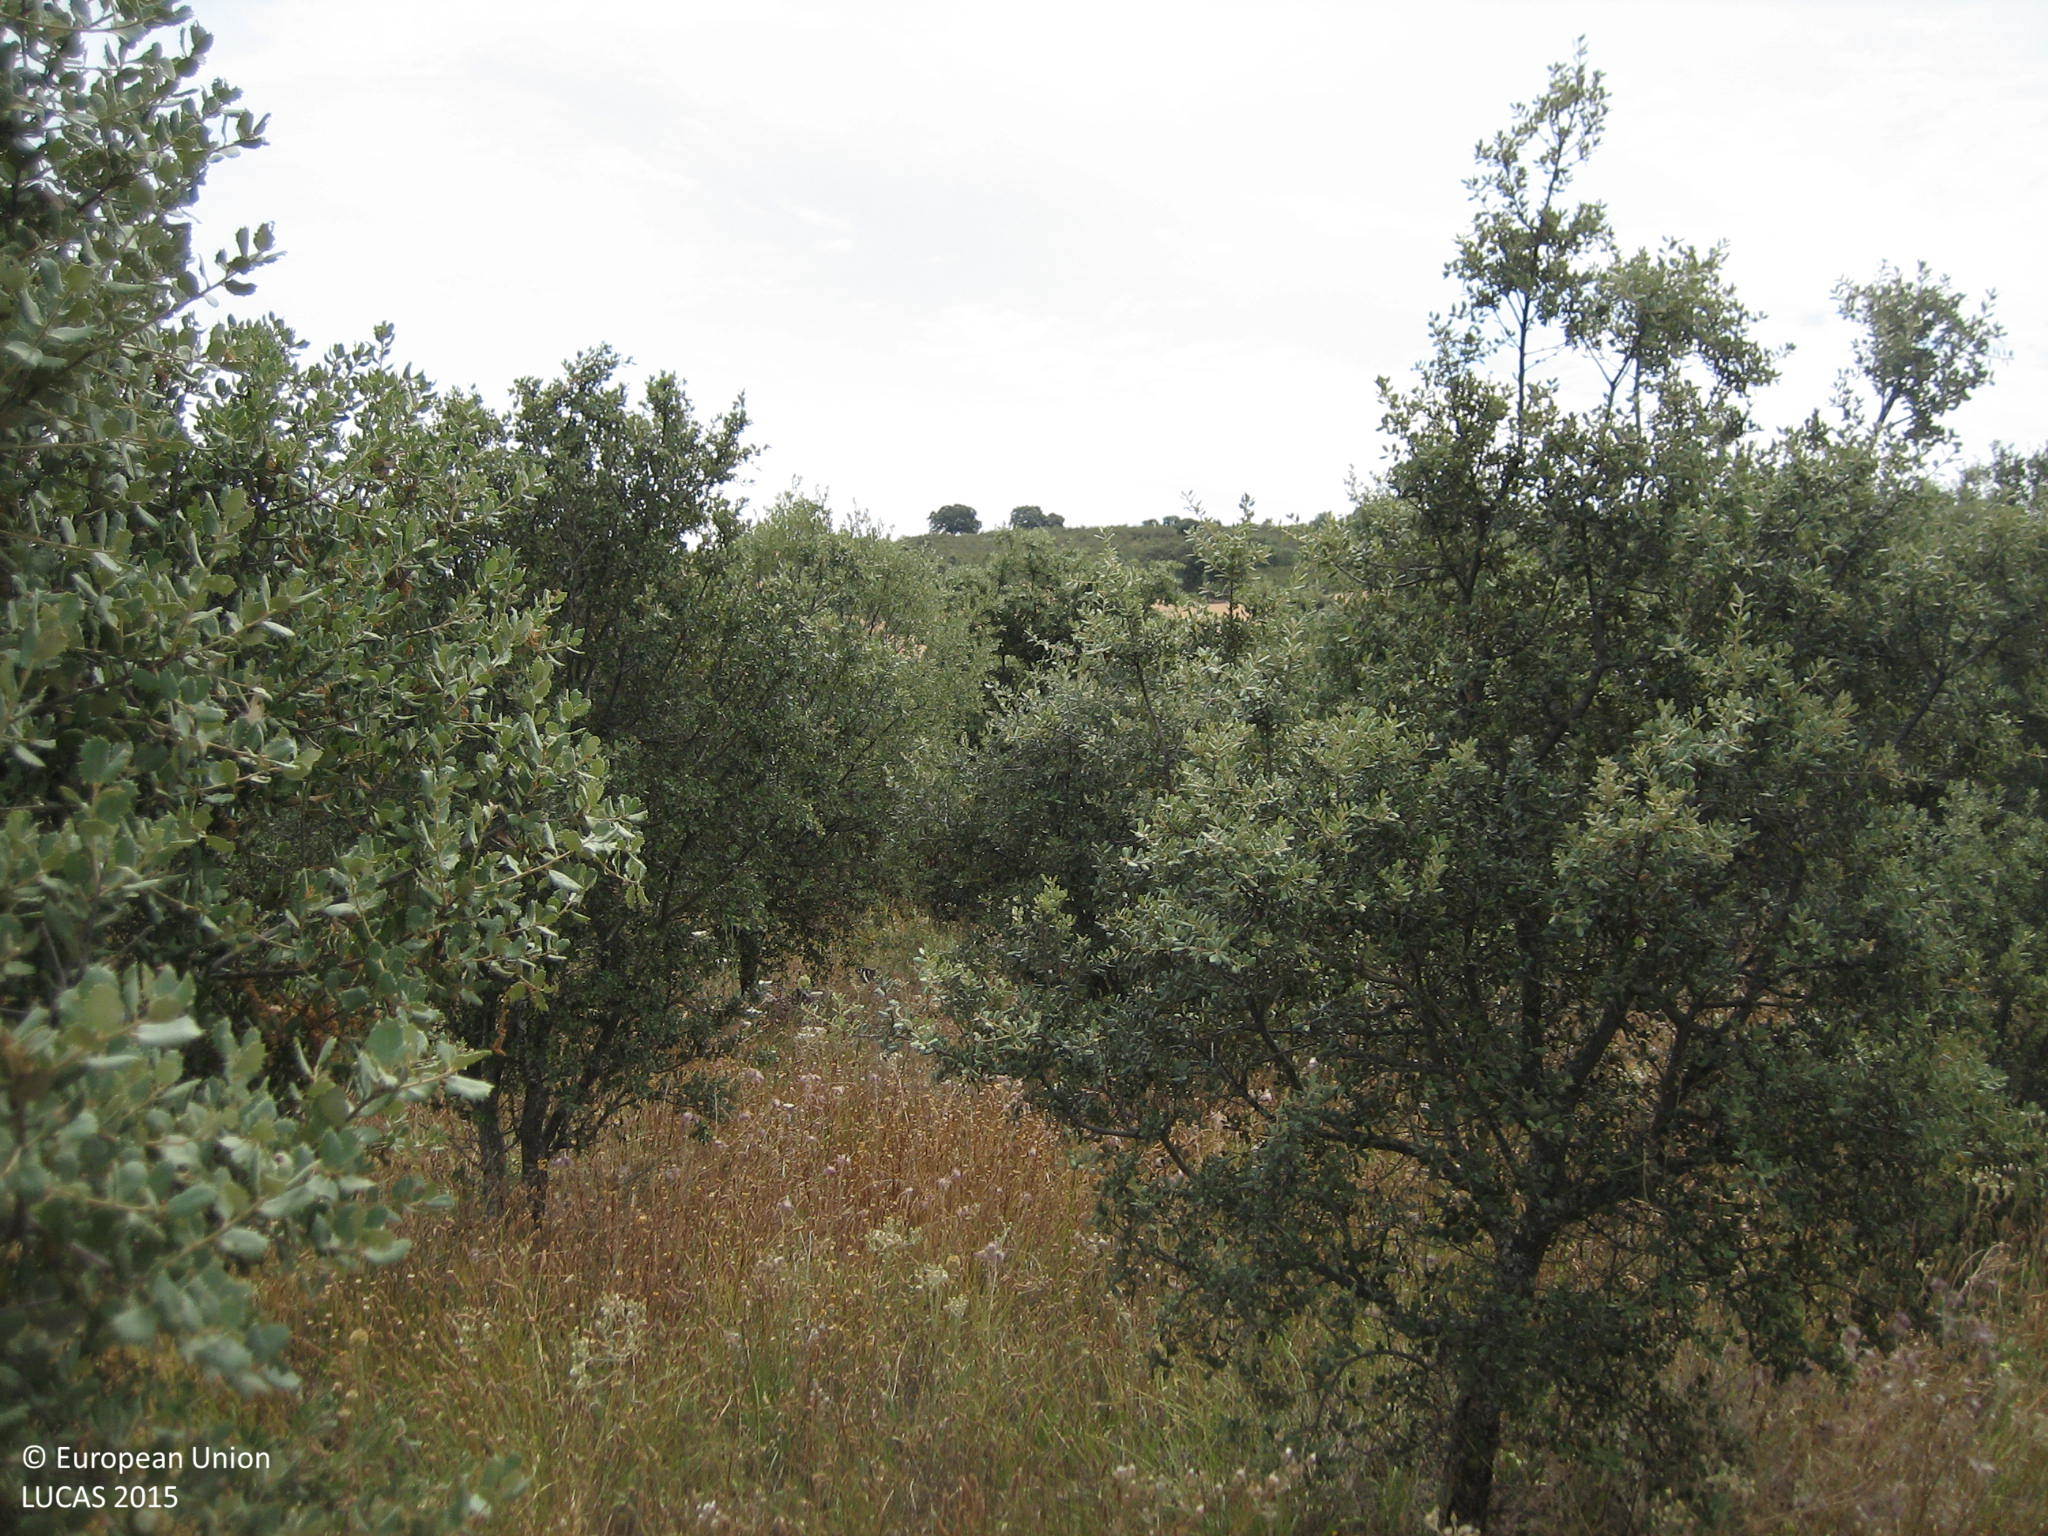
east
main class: Woodland
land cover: Broadleaved woodland
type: broadleaved evergreen forest
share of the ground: 25 - 50 %
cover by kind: herbaceous plants 60 %, broadleaved forest trees 40 %
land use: Forestry
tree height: < 5 m
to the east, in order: Broadleaved woodland; Fences; Oats; Groves; Oats; Grass margins; Oats
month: June
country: ES
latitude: 39.1818
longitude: -4.5133
